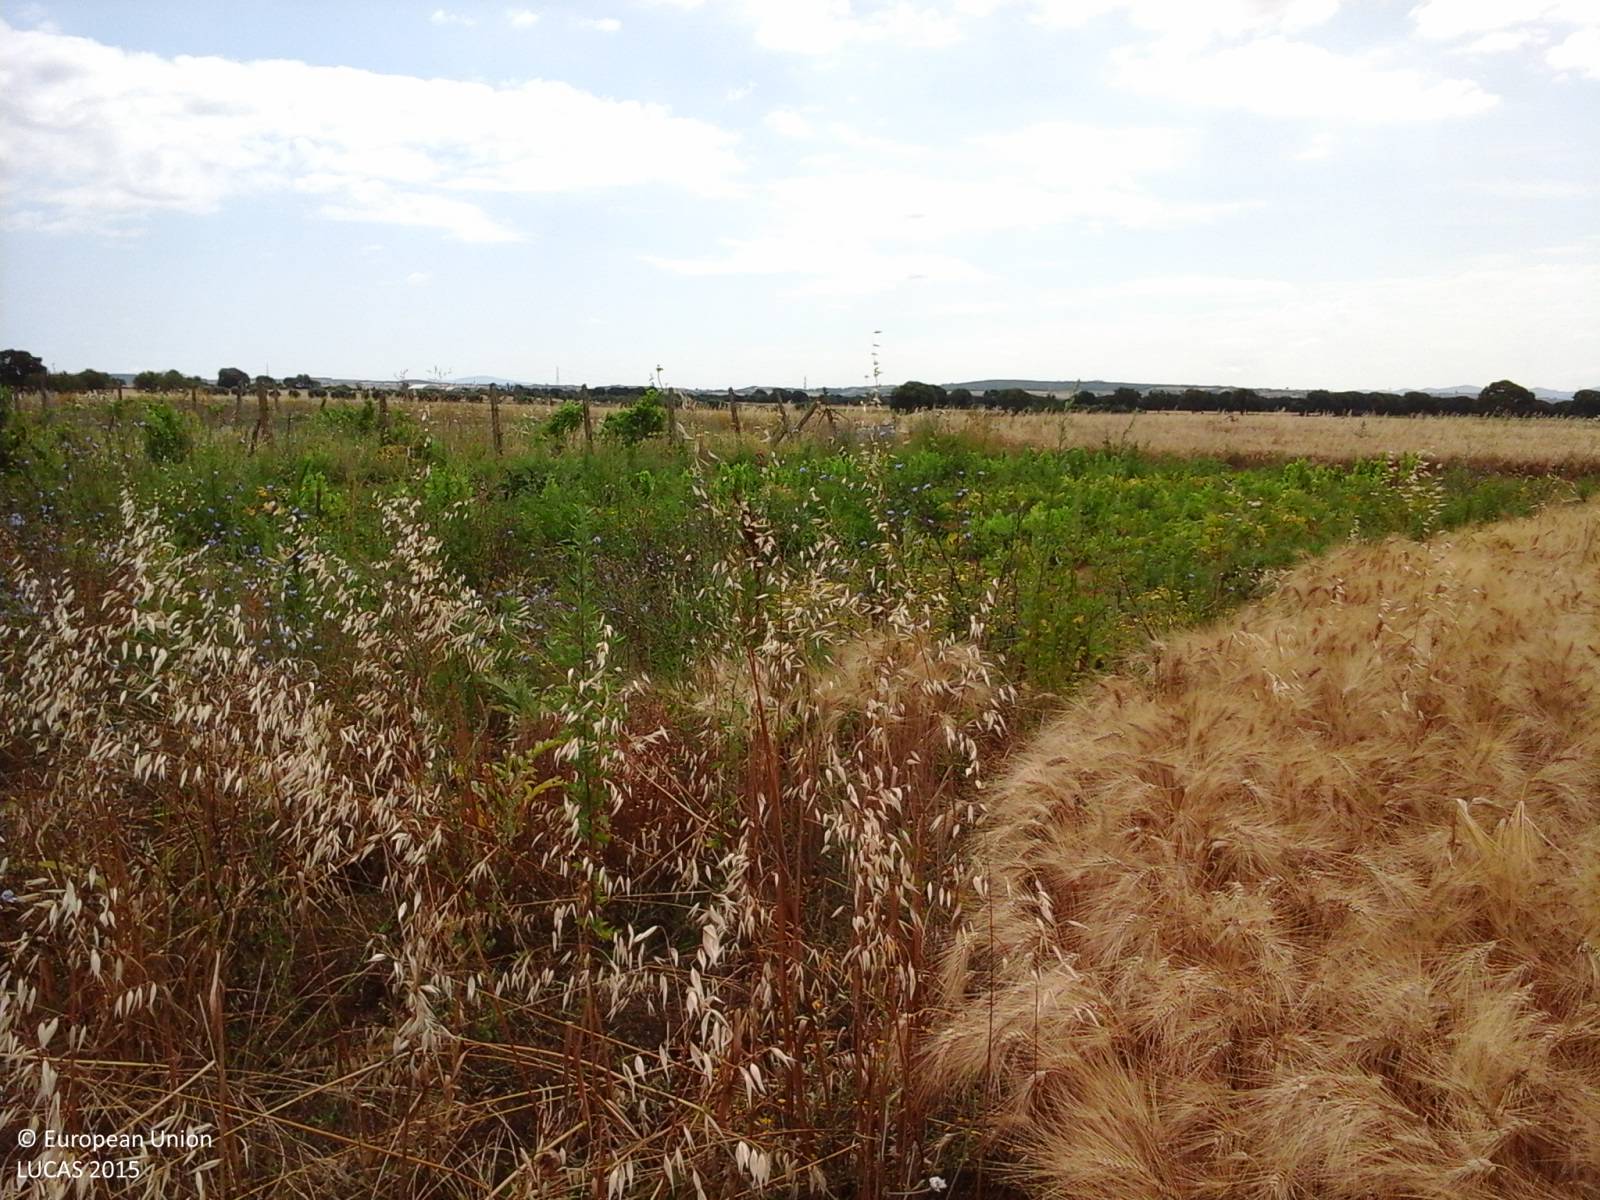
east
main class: Cropland
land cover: Durum wheat
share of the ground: > 75 %
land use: Agriculture (excluding fallow land and kitchen gardens)
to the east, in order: Durum wheat; Grass margins; Vineyards; Other fresh vegetables; Tracks; Grass margins; Barley; Other fresh vegetables; Tracks; Grass margins; Ditches and canals; Grass margins; Tracks; Other fresh vegetables
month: June
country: IT
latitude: 42.2972
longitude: 11.6558
